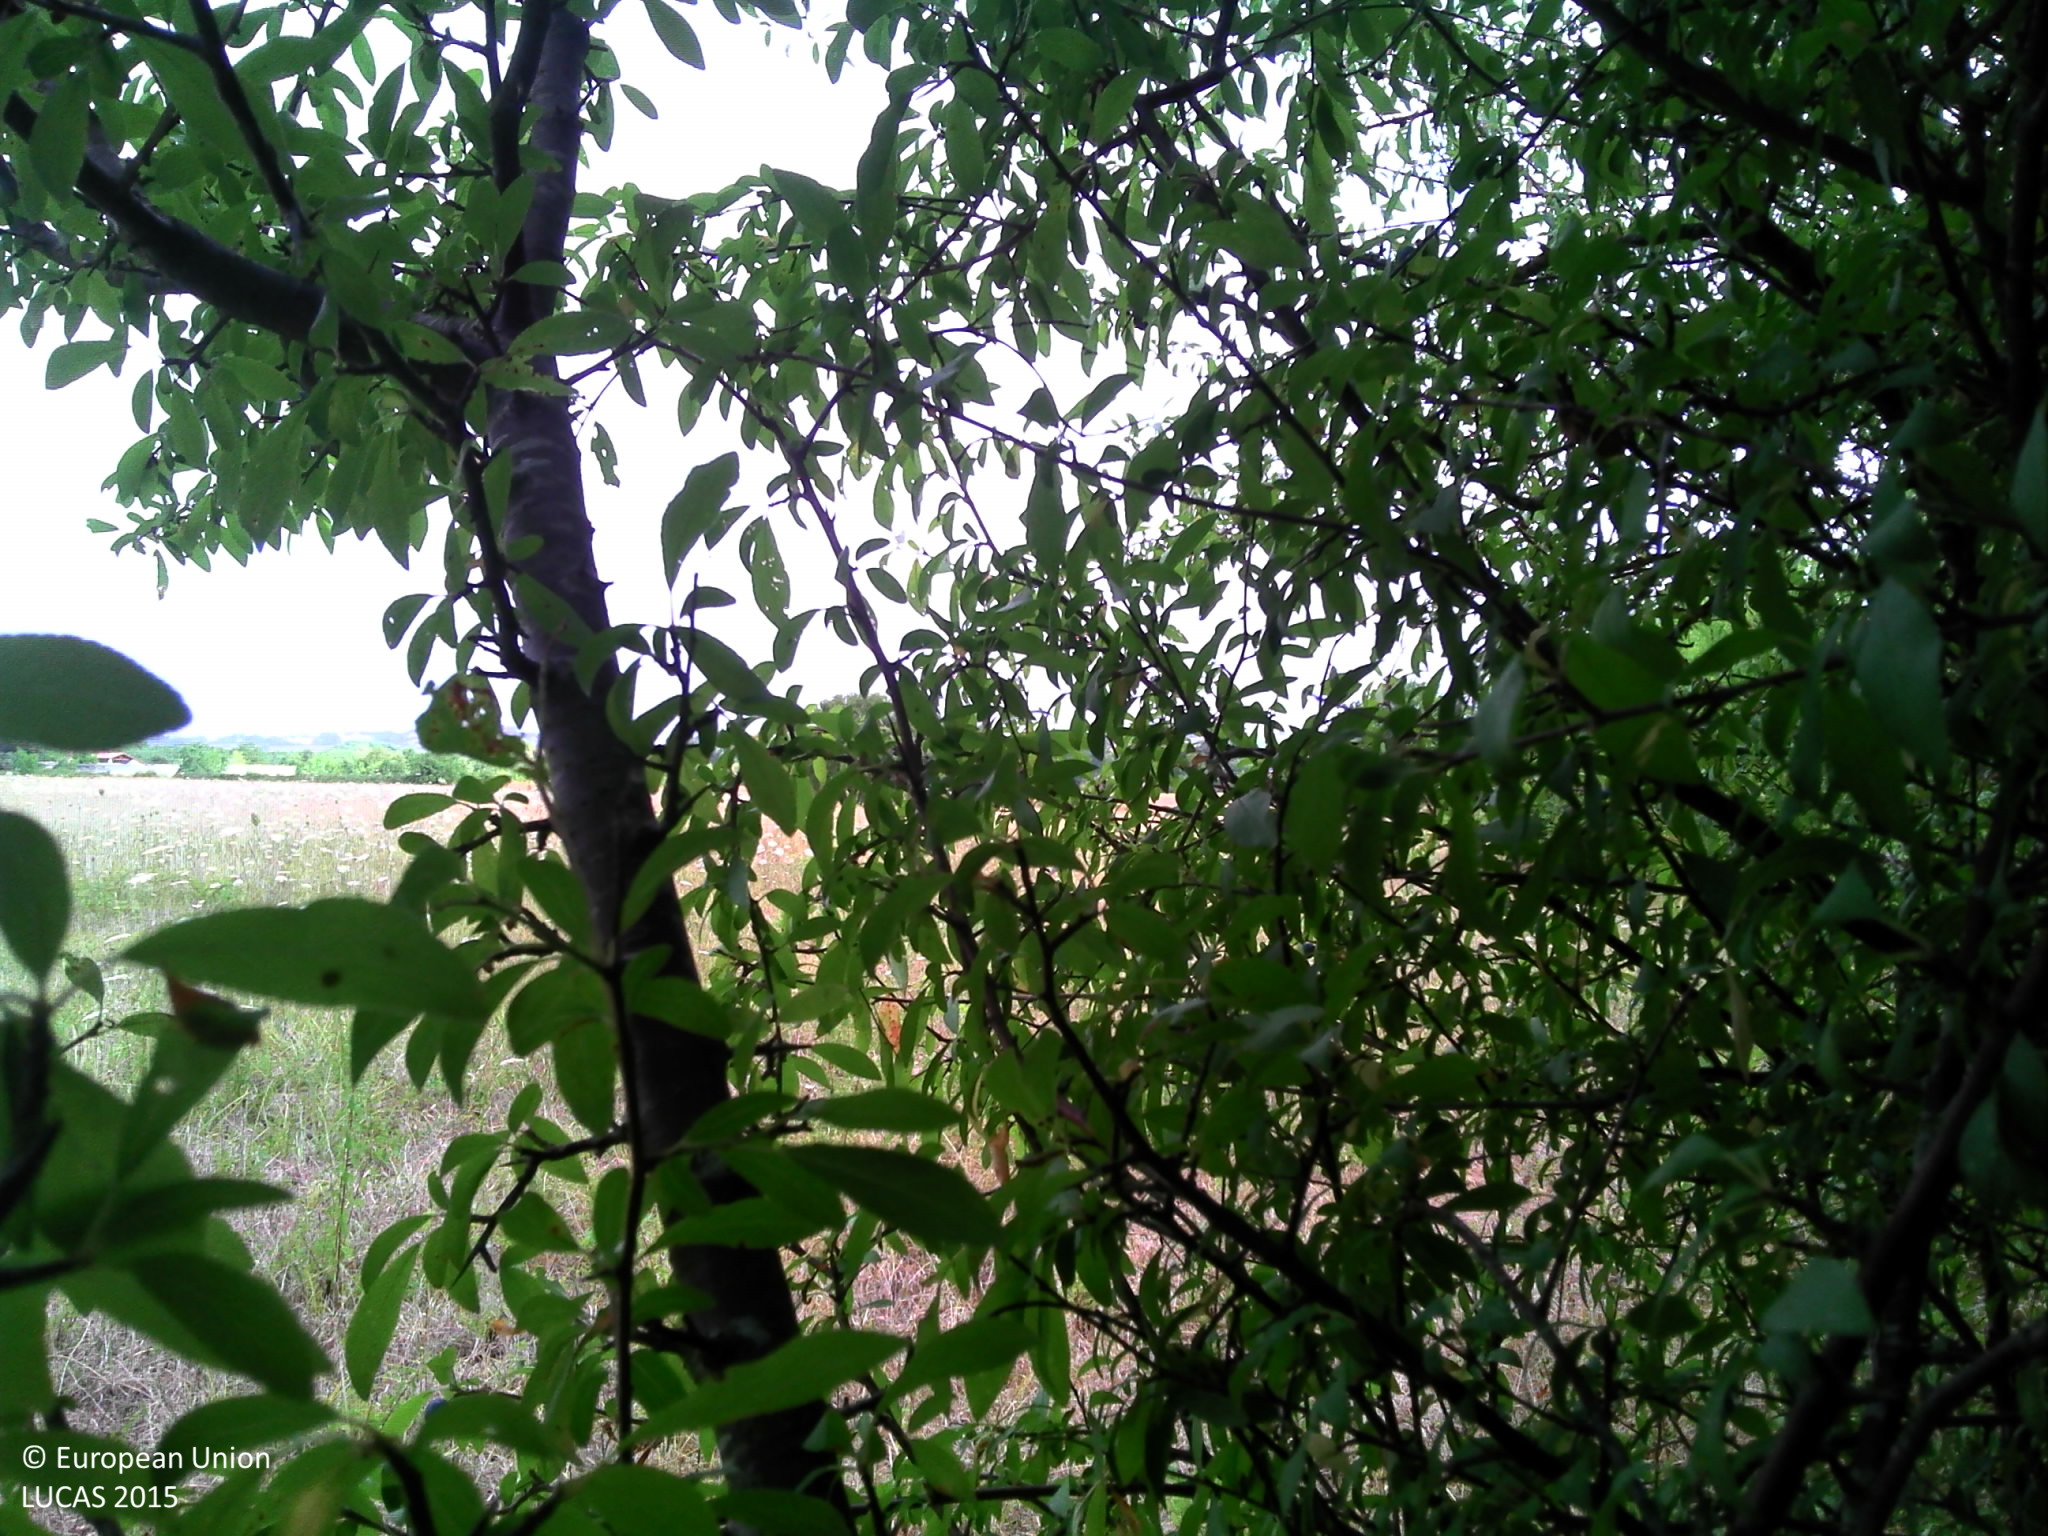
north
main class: Woodland
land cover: Broadleaved woodland
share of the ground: > 75 %
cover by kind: broadleaved forest trees 95 %, shrubs 5 %
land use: Semi-natural and natural areas not in use
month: July
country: FR
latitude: 44.4096
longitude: 0.5624
